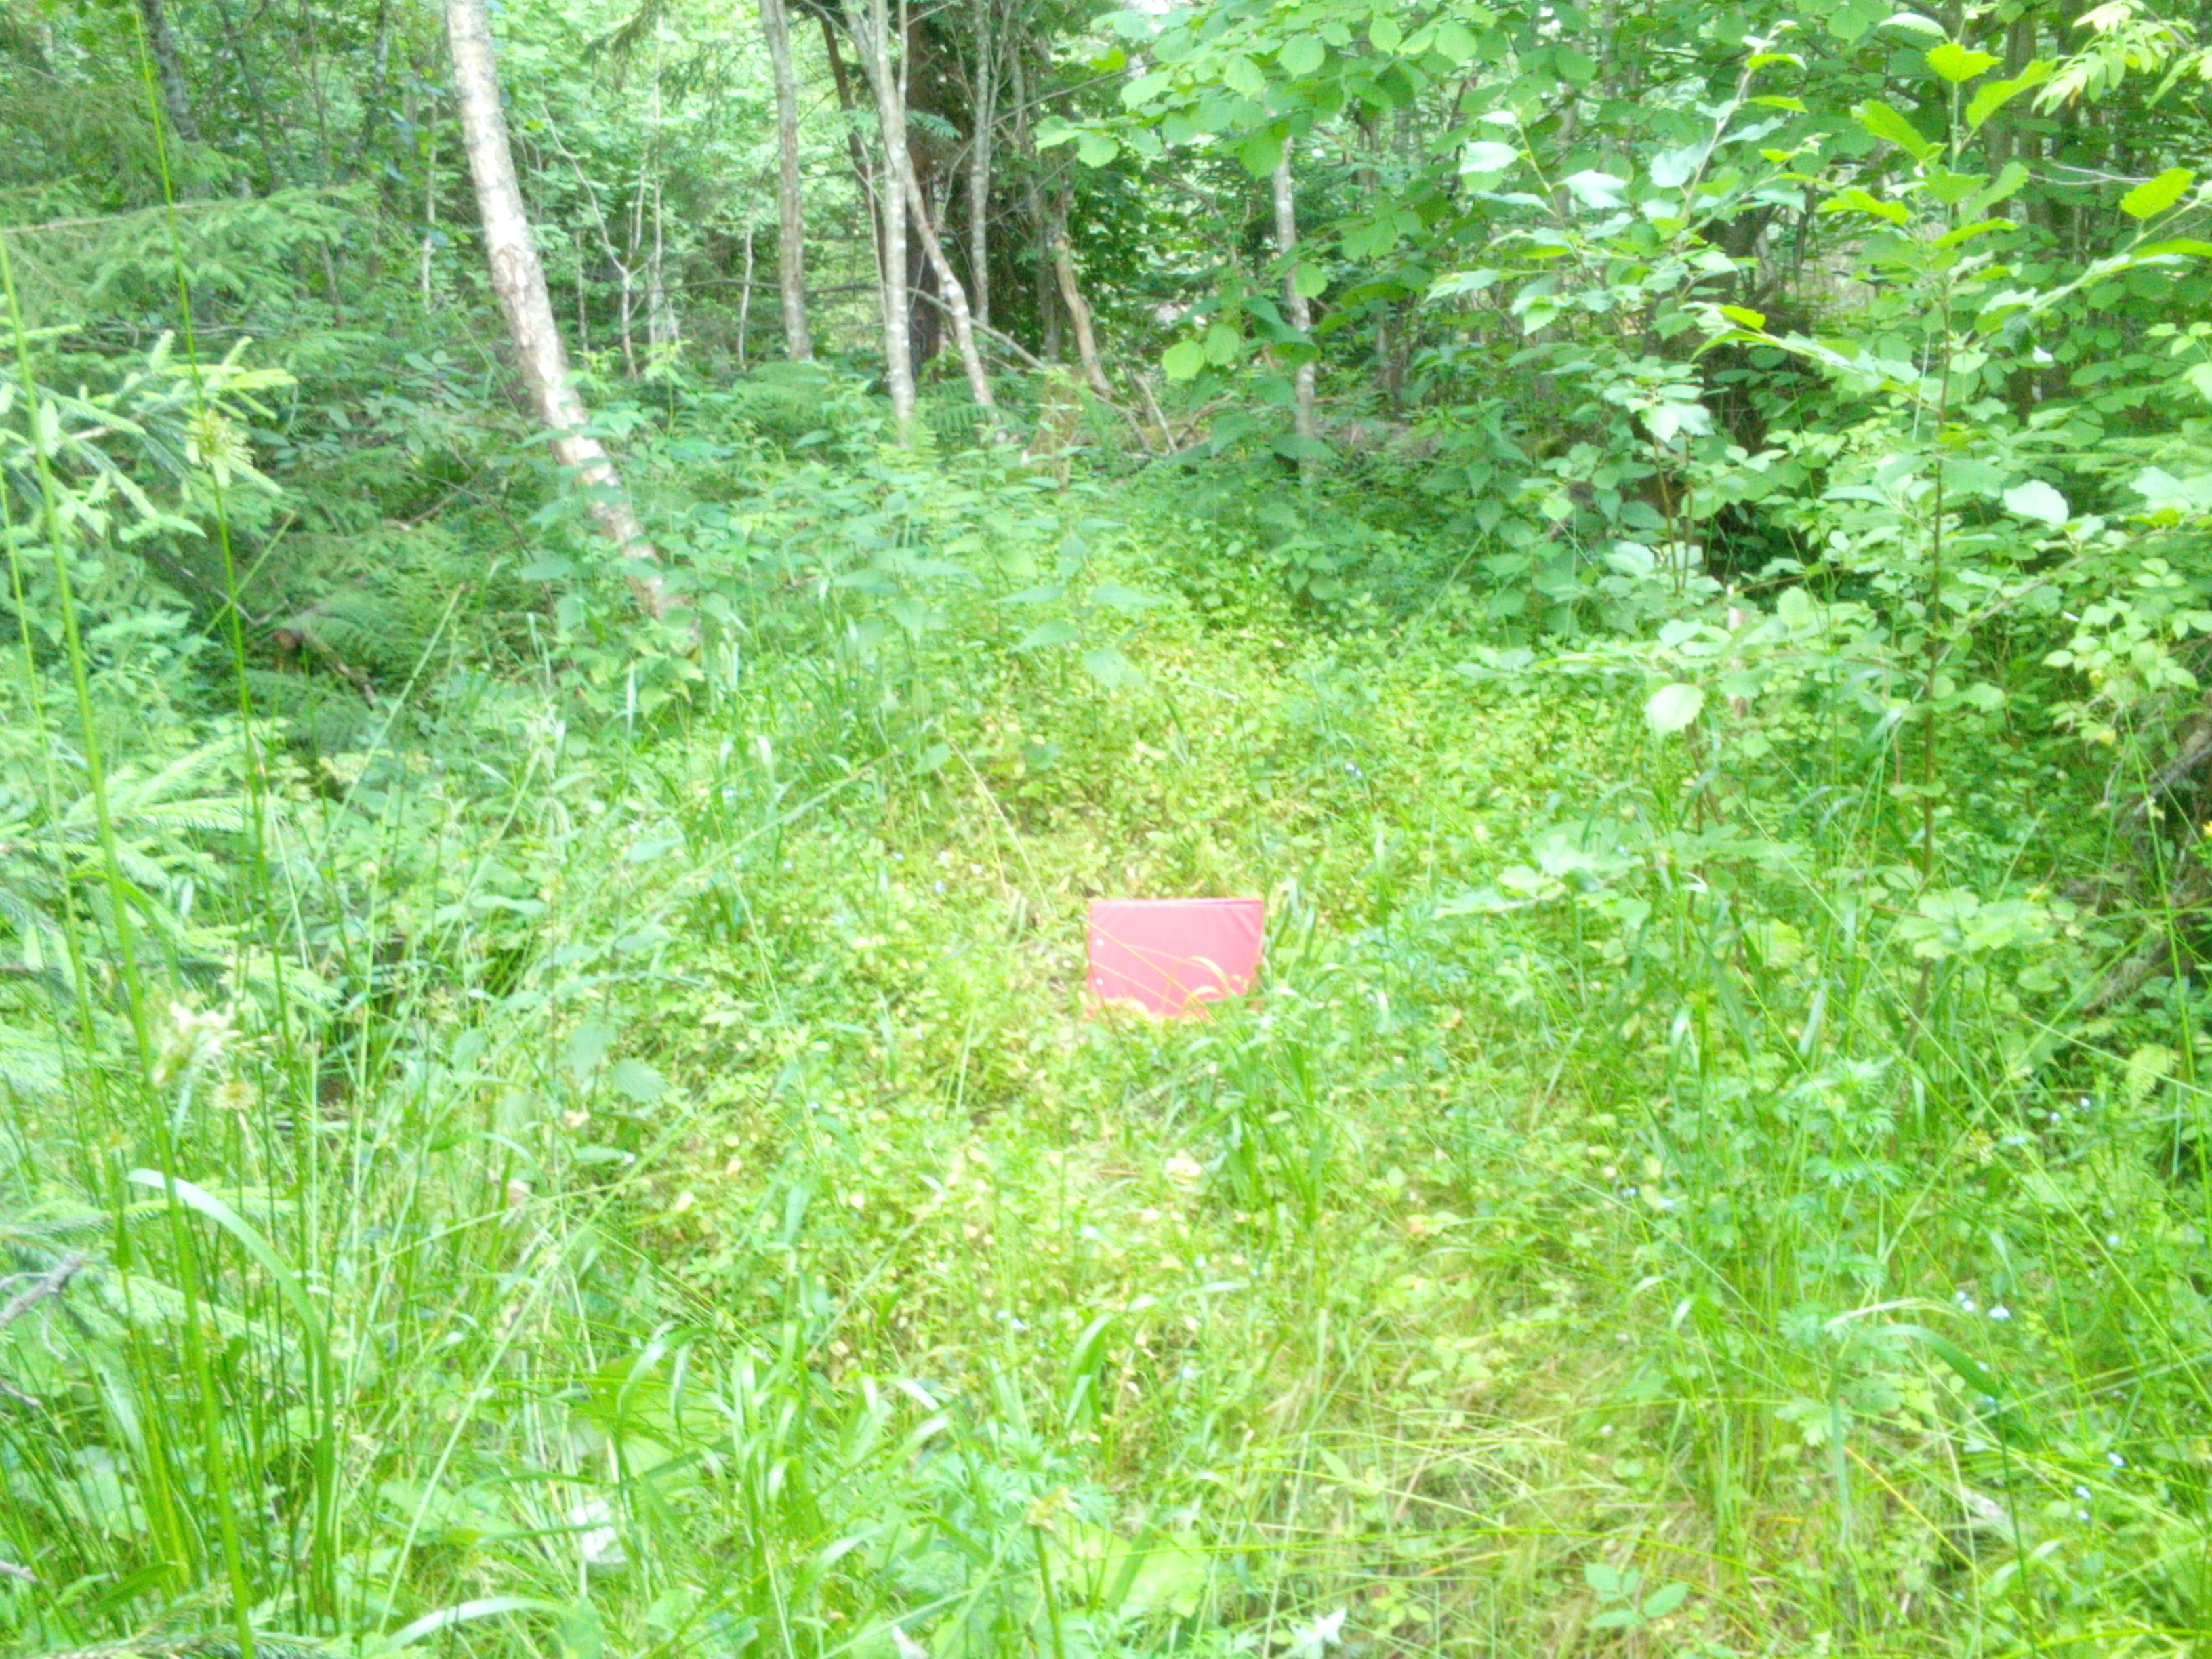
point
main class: Woodland
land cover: Spruce dominated mixed woodland
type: hemiboreal forest and nemoral coniferous forest and mixed broadleaved-coniferous forest
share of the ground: > 75 %
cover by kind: broadleaved forest trees 55 %, coniferous forest trees 30 %, herbaceous plants 10 %, shrubs 5 %
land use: Forestry
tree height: > 5 m
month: July
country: LV
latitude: 56.5885
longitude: 21.7861
